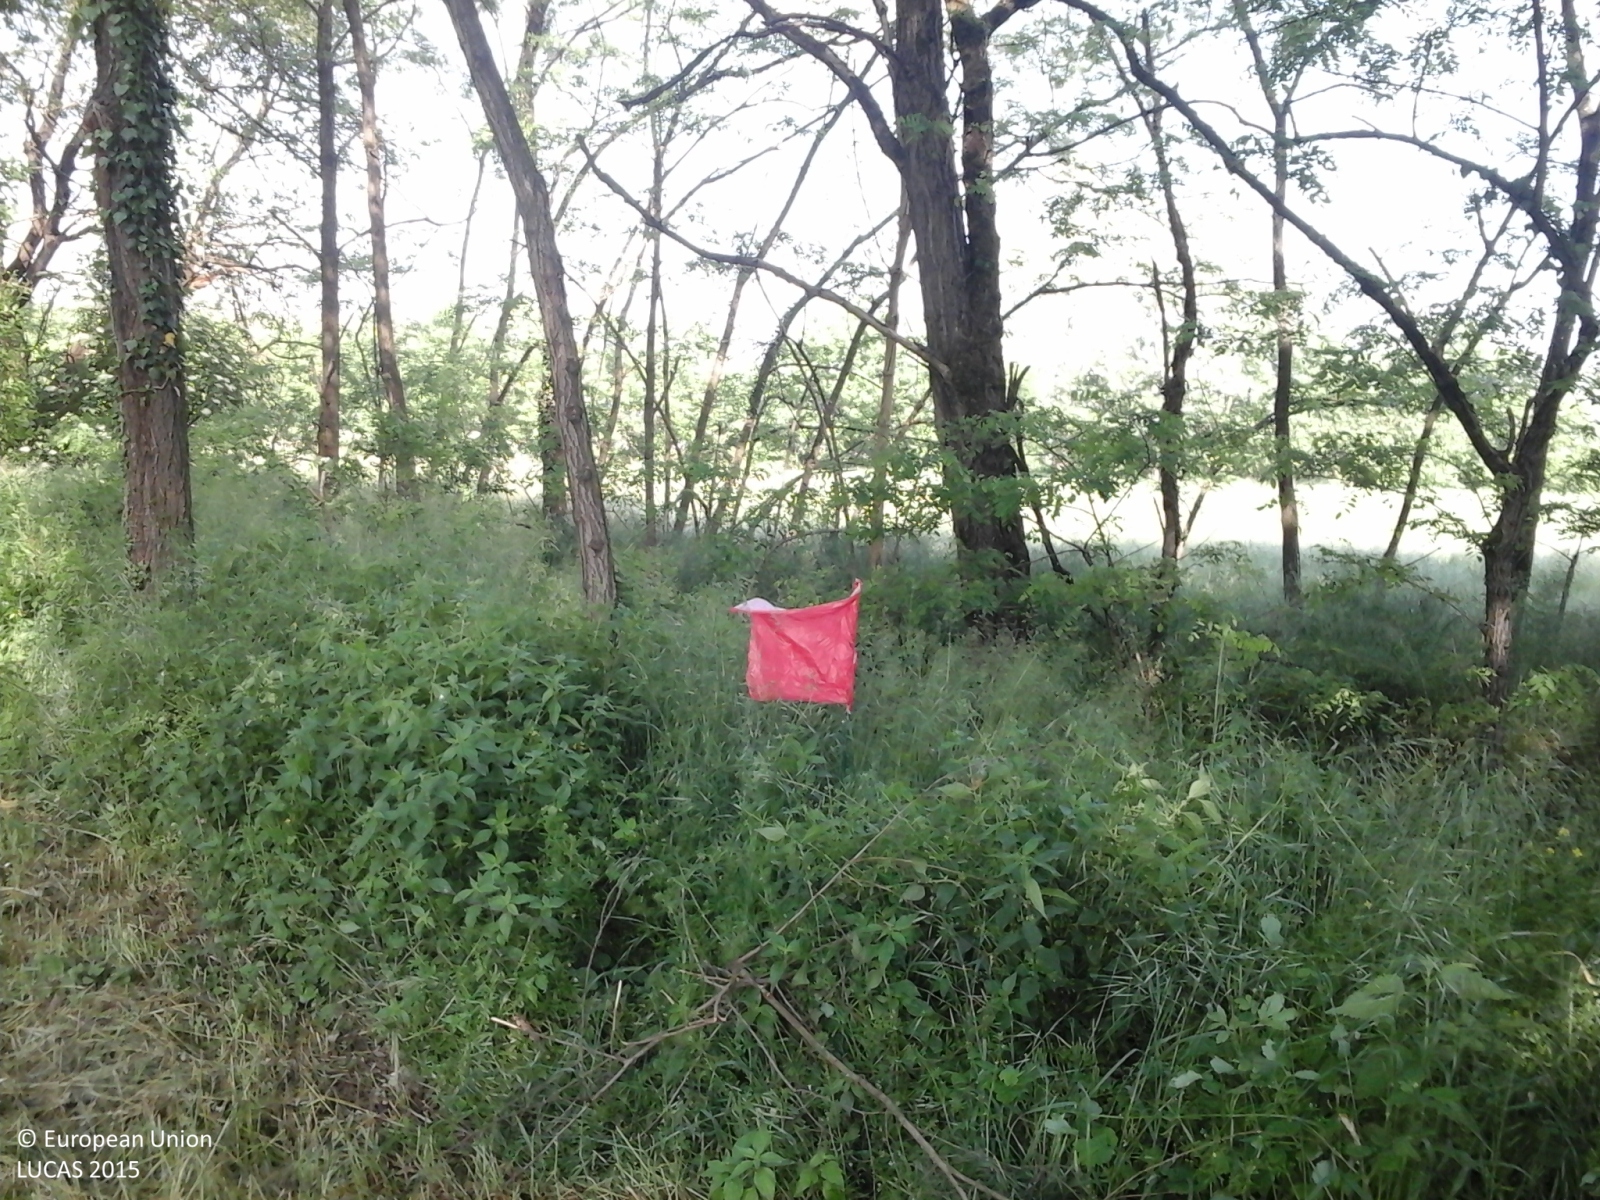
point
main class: Woodland
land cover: Broadleaved woodland
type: floodplain forest
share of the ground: 25 - 50 %
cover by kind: broadleaved forest trees 50 %, herbaceous plants 50 %
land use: Forestry
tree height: > 5 m
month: May
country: IT
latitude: 45.2122
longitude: 9.0976
